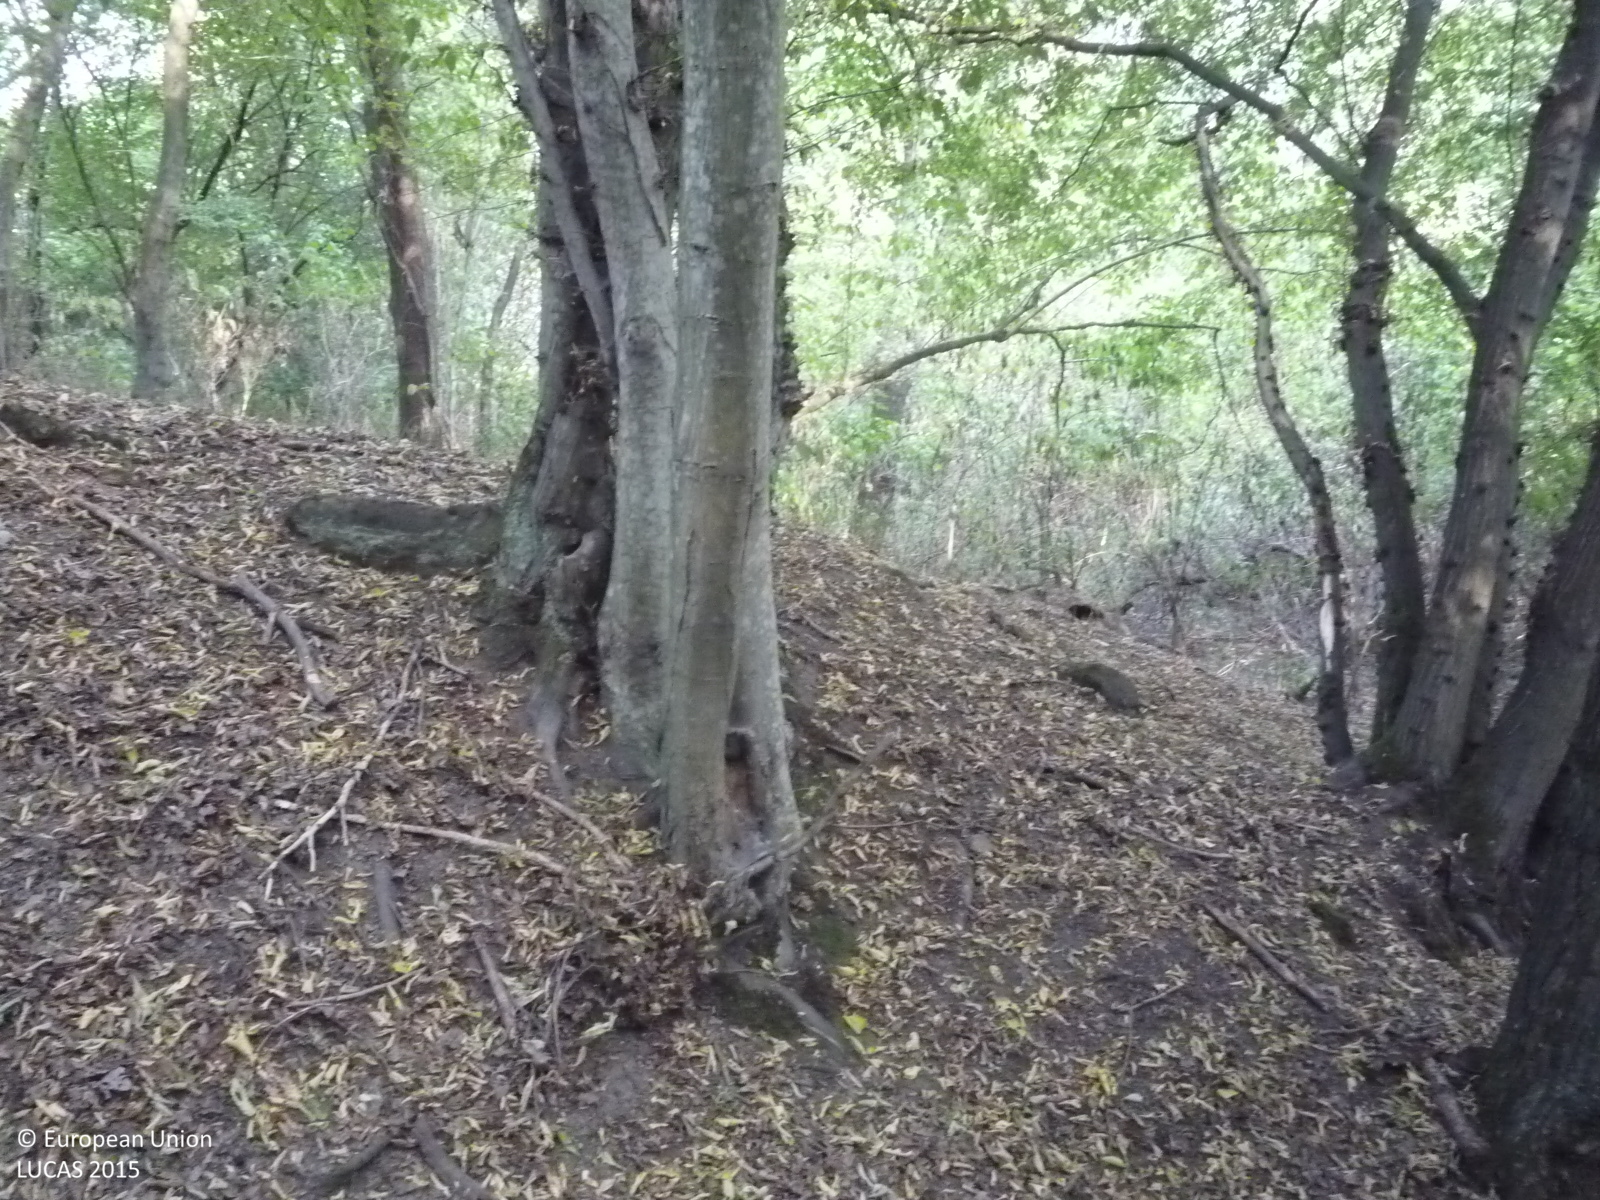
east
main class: Woodland
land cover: Broadleaved woodland
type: mesophytic deciduous forest
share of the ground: > 75 %
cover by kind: broadleaved forest trees 95 %, unconsolidated bare surface 5 %
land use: Forestry
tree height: > 5 m
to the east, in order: Broadleaved woodland; Grassland without tree/shrub cover; Broadleaved woodland; Grassland with sparse tree/shrub cover; Artificial constructions in urban areas
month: August
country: CZ
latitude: 49.8267
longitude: 14.4638
